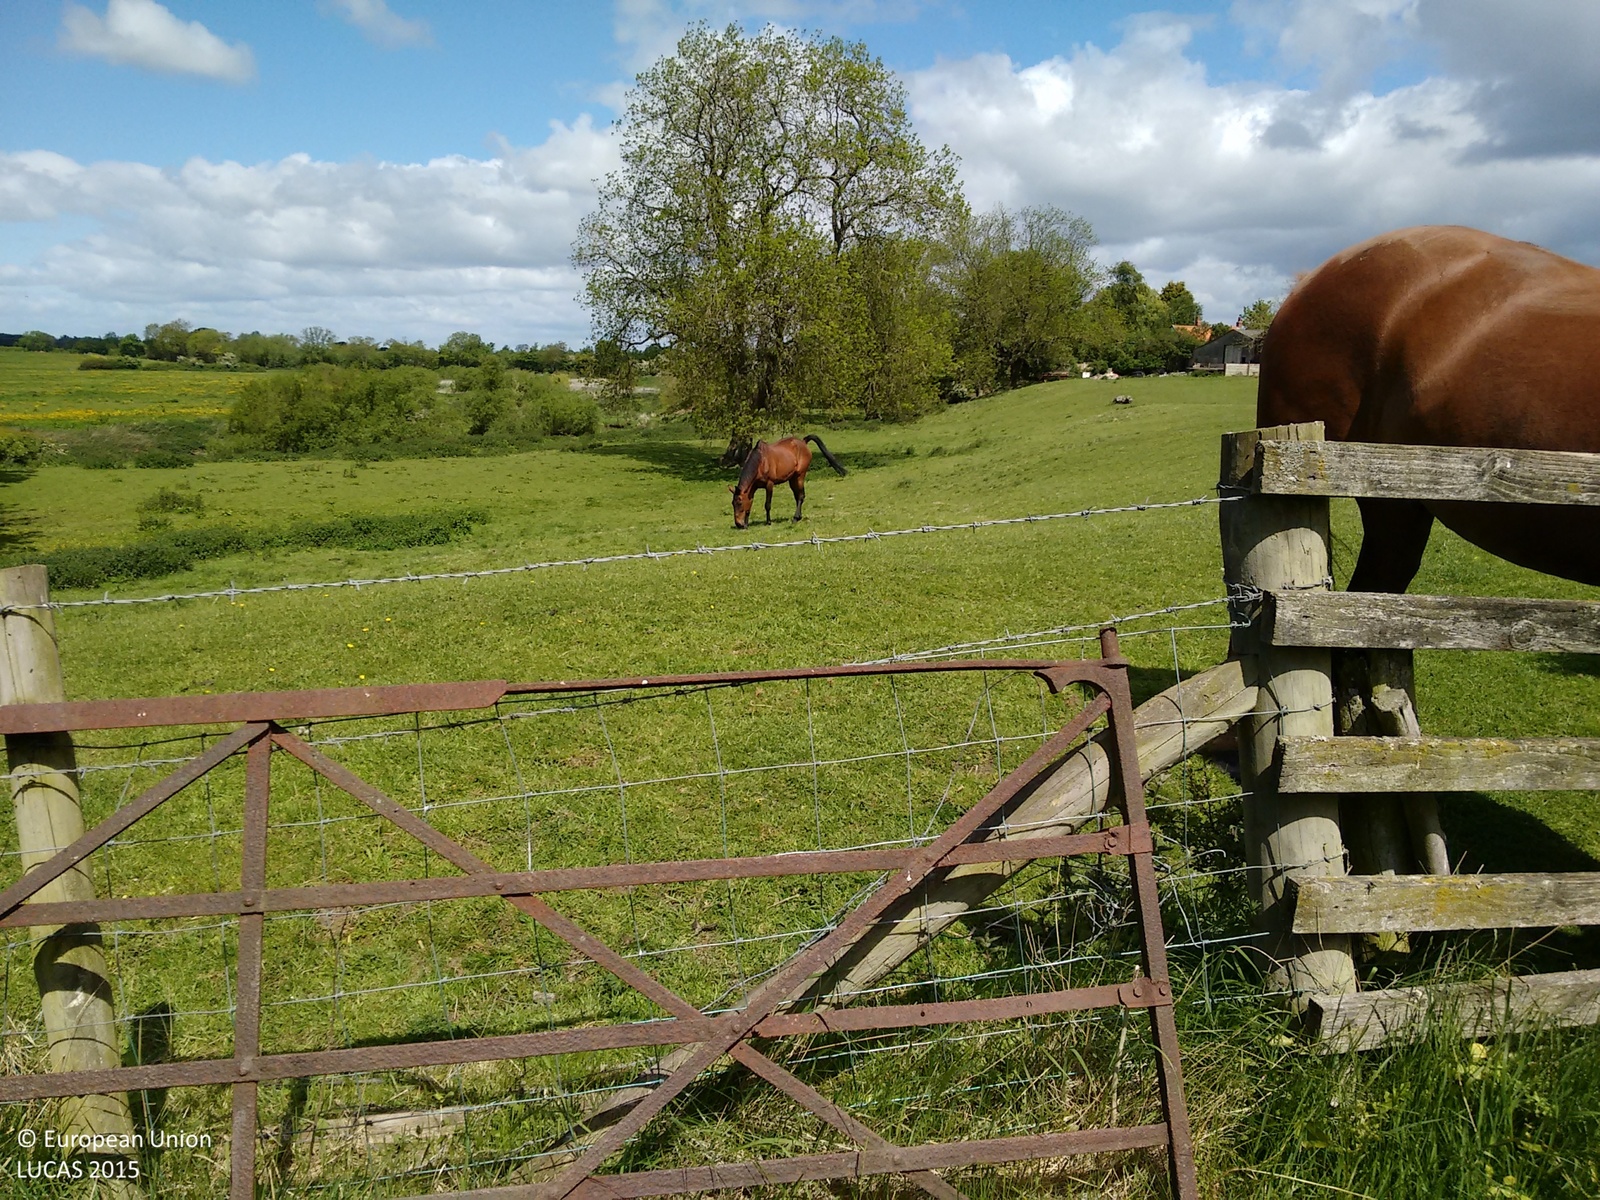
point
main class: Grassland
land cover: Grassland without tree/shrub cover
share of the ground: > 75 %
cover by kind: herbaceous plants 100 %
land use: Agriculture (excluding fallow land and kitchen gardens)
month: May
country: GB
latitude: 54.0037
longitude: -1.2290
